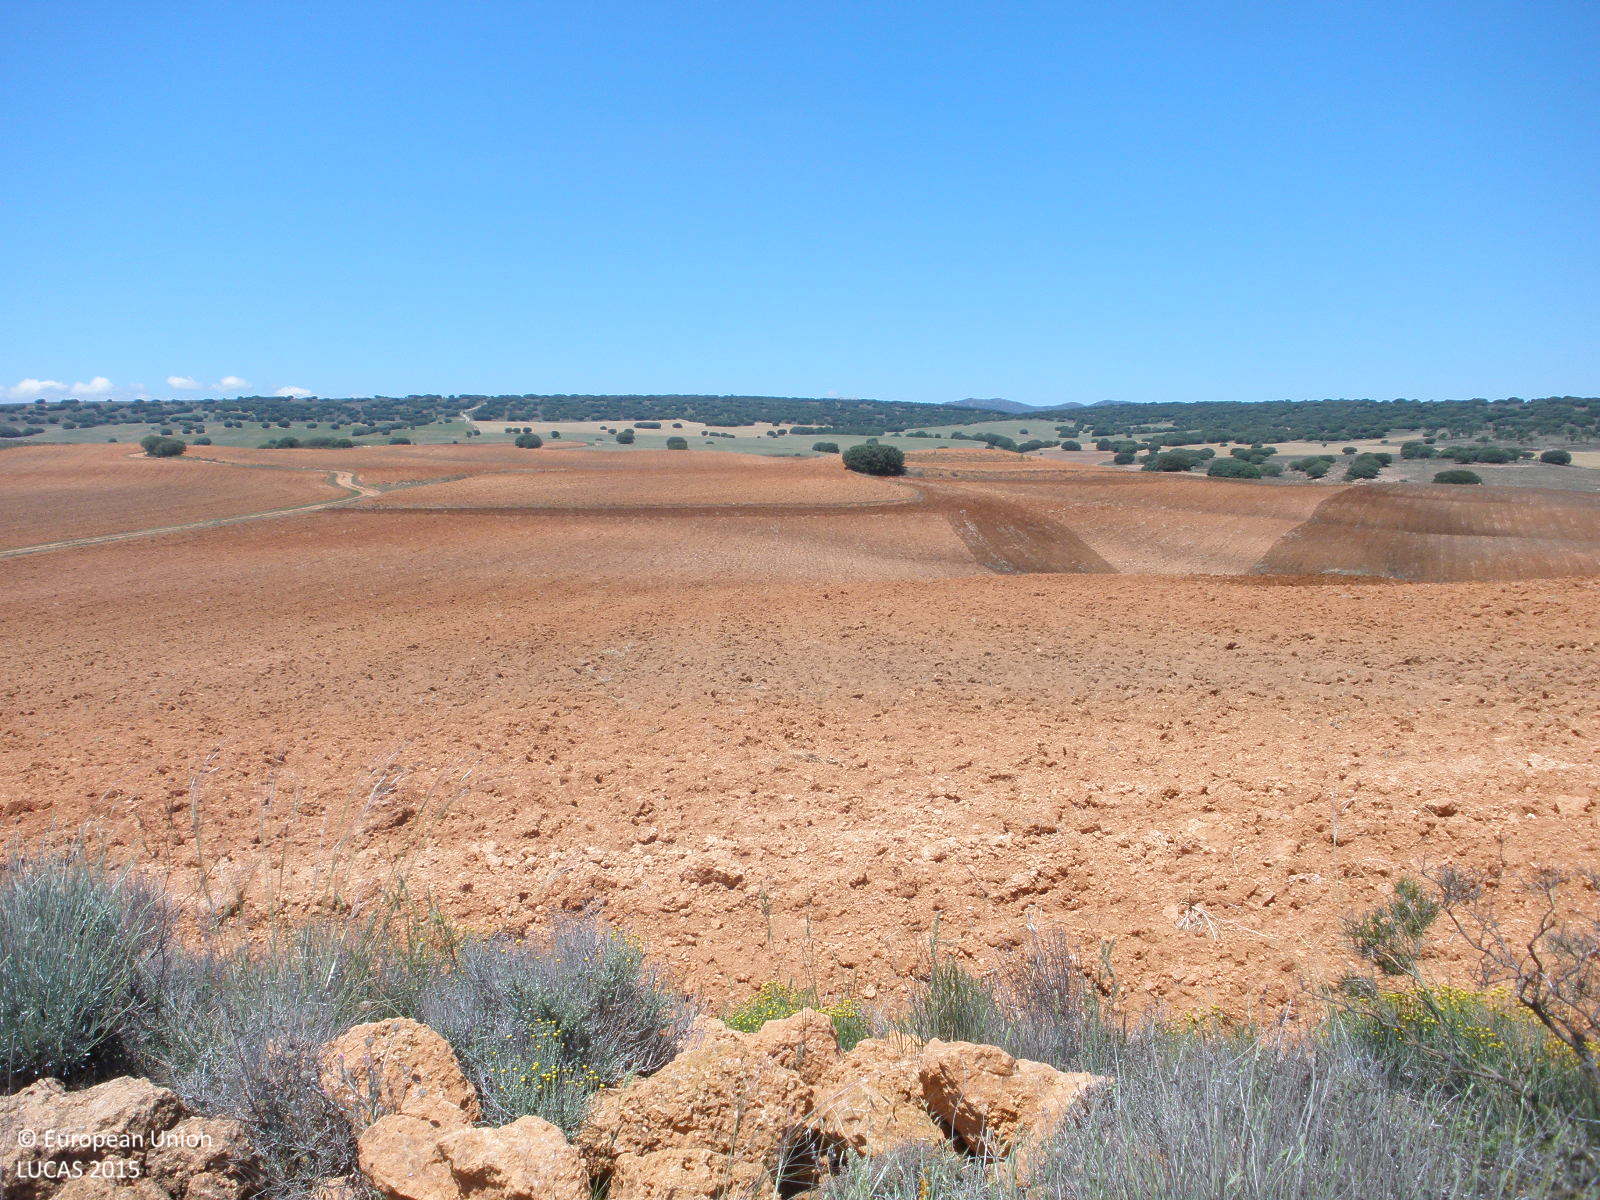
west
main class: Shrubland
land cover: Shrubland without tree cover
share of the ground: > 75 %
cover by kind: shrubs 75 %, consolidated bare surface 15 %, herbaceous plants 10 %
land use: Semi-natural and natural areas not in use
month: June
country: ES
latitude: 40.5680
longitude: -1.0803
